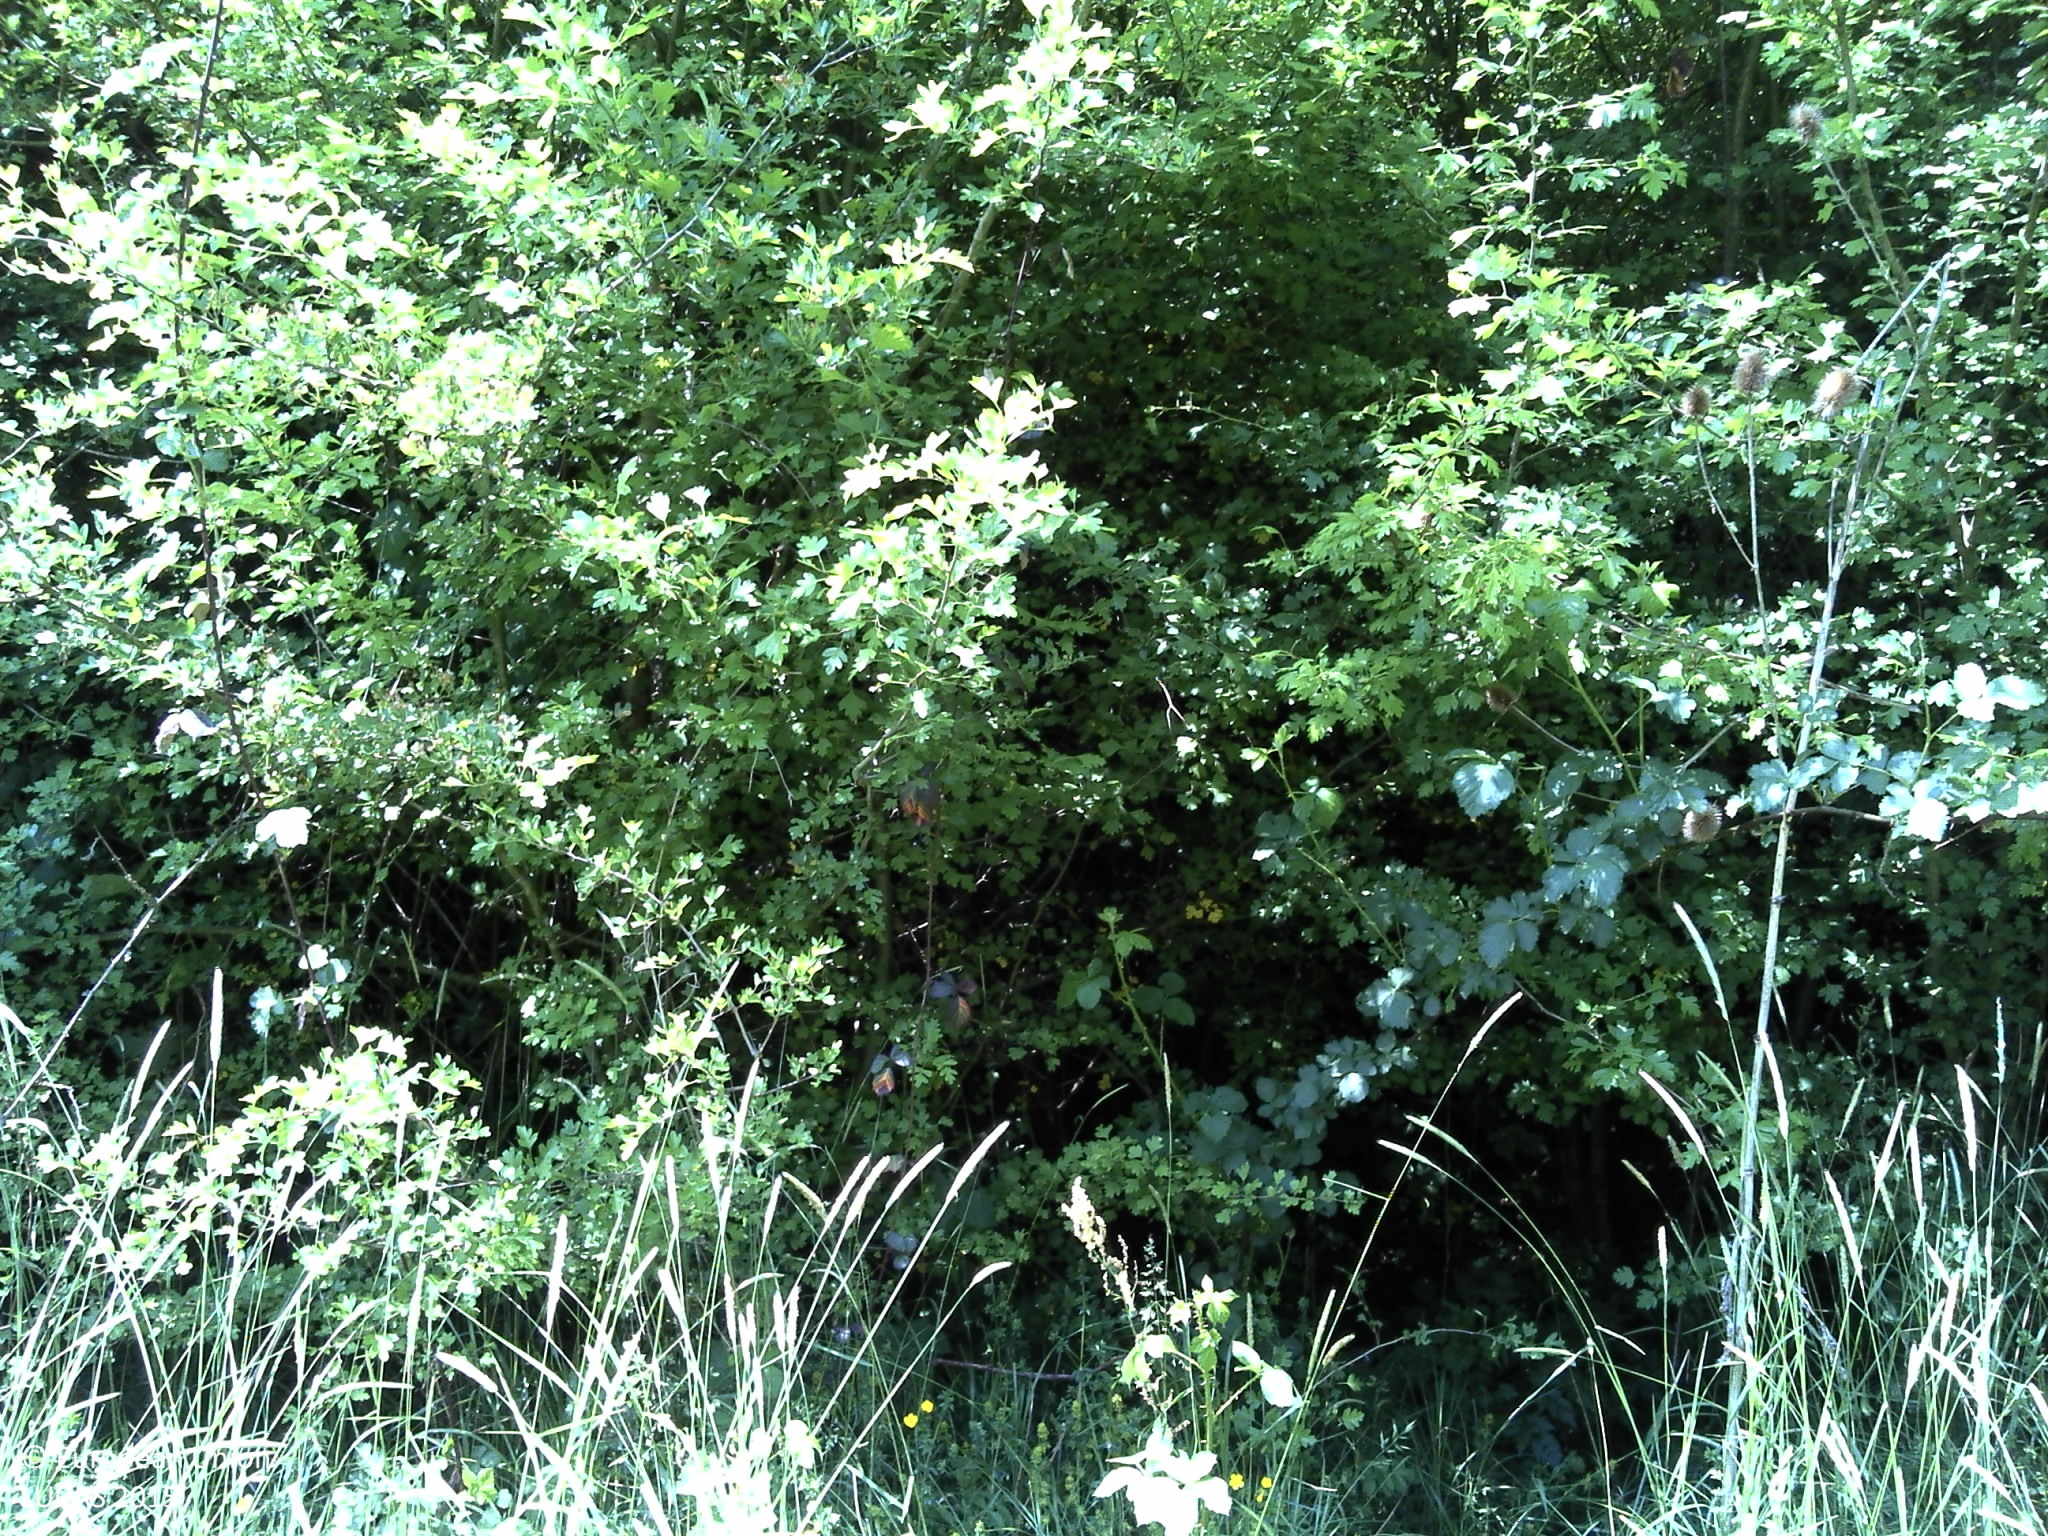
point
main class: Shrubland
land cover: Shrubland with sparse tree cover
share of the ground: > 75 %
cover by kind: shrubs 95 %, broadleaved forest trees 5 %
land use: Forestry
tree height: > 5 m
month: May
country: HR
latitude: 45.6236
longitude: 18.1493
